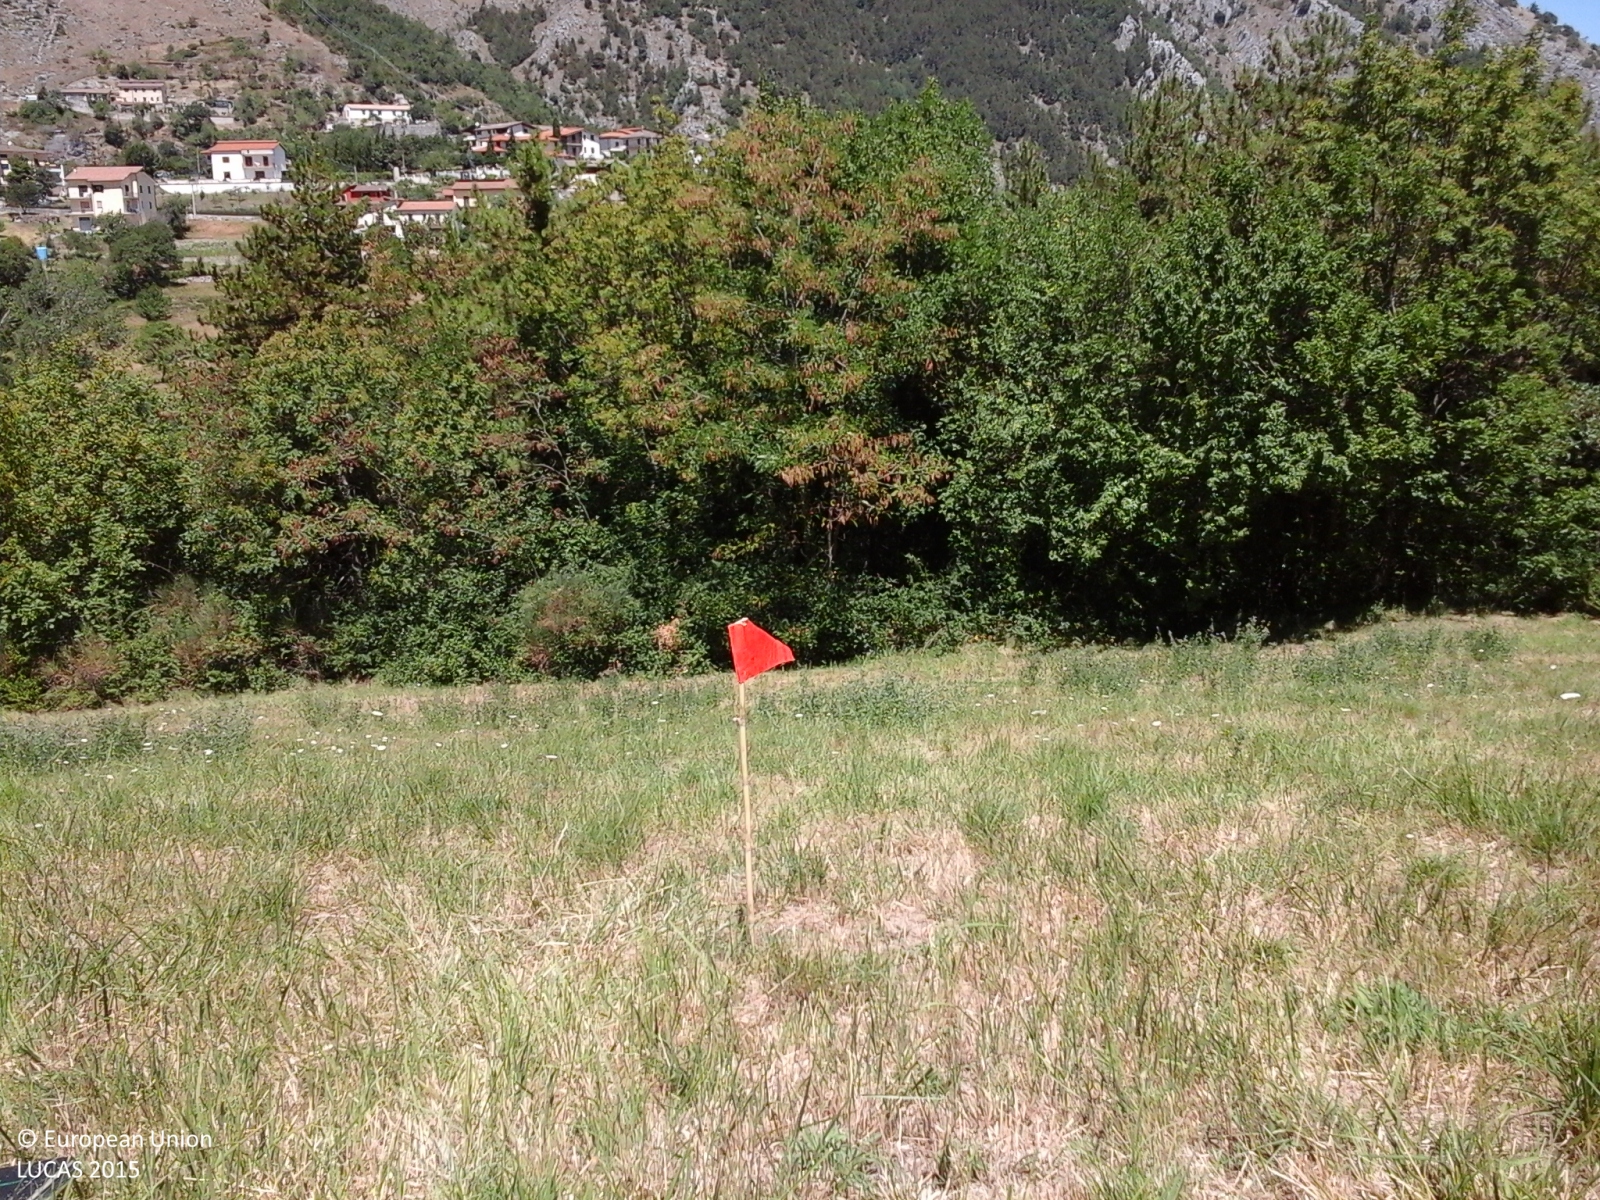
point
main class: Grassland
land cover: Grassland without tree/shrub cover
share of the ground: > 75 %
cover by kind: herbaceous plants 100 %
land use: Agriculture (excluding fallow land and kitchen gardens)
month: July
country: IT
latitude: 41.4928
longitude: 14.3562
